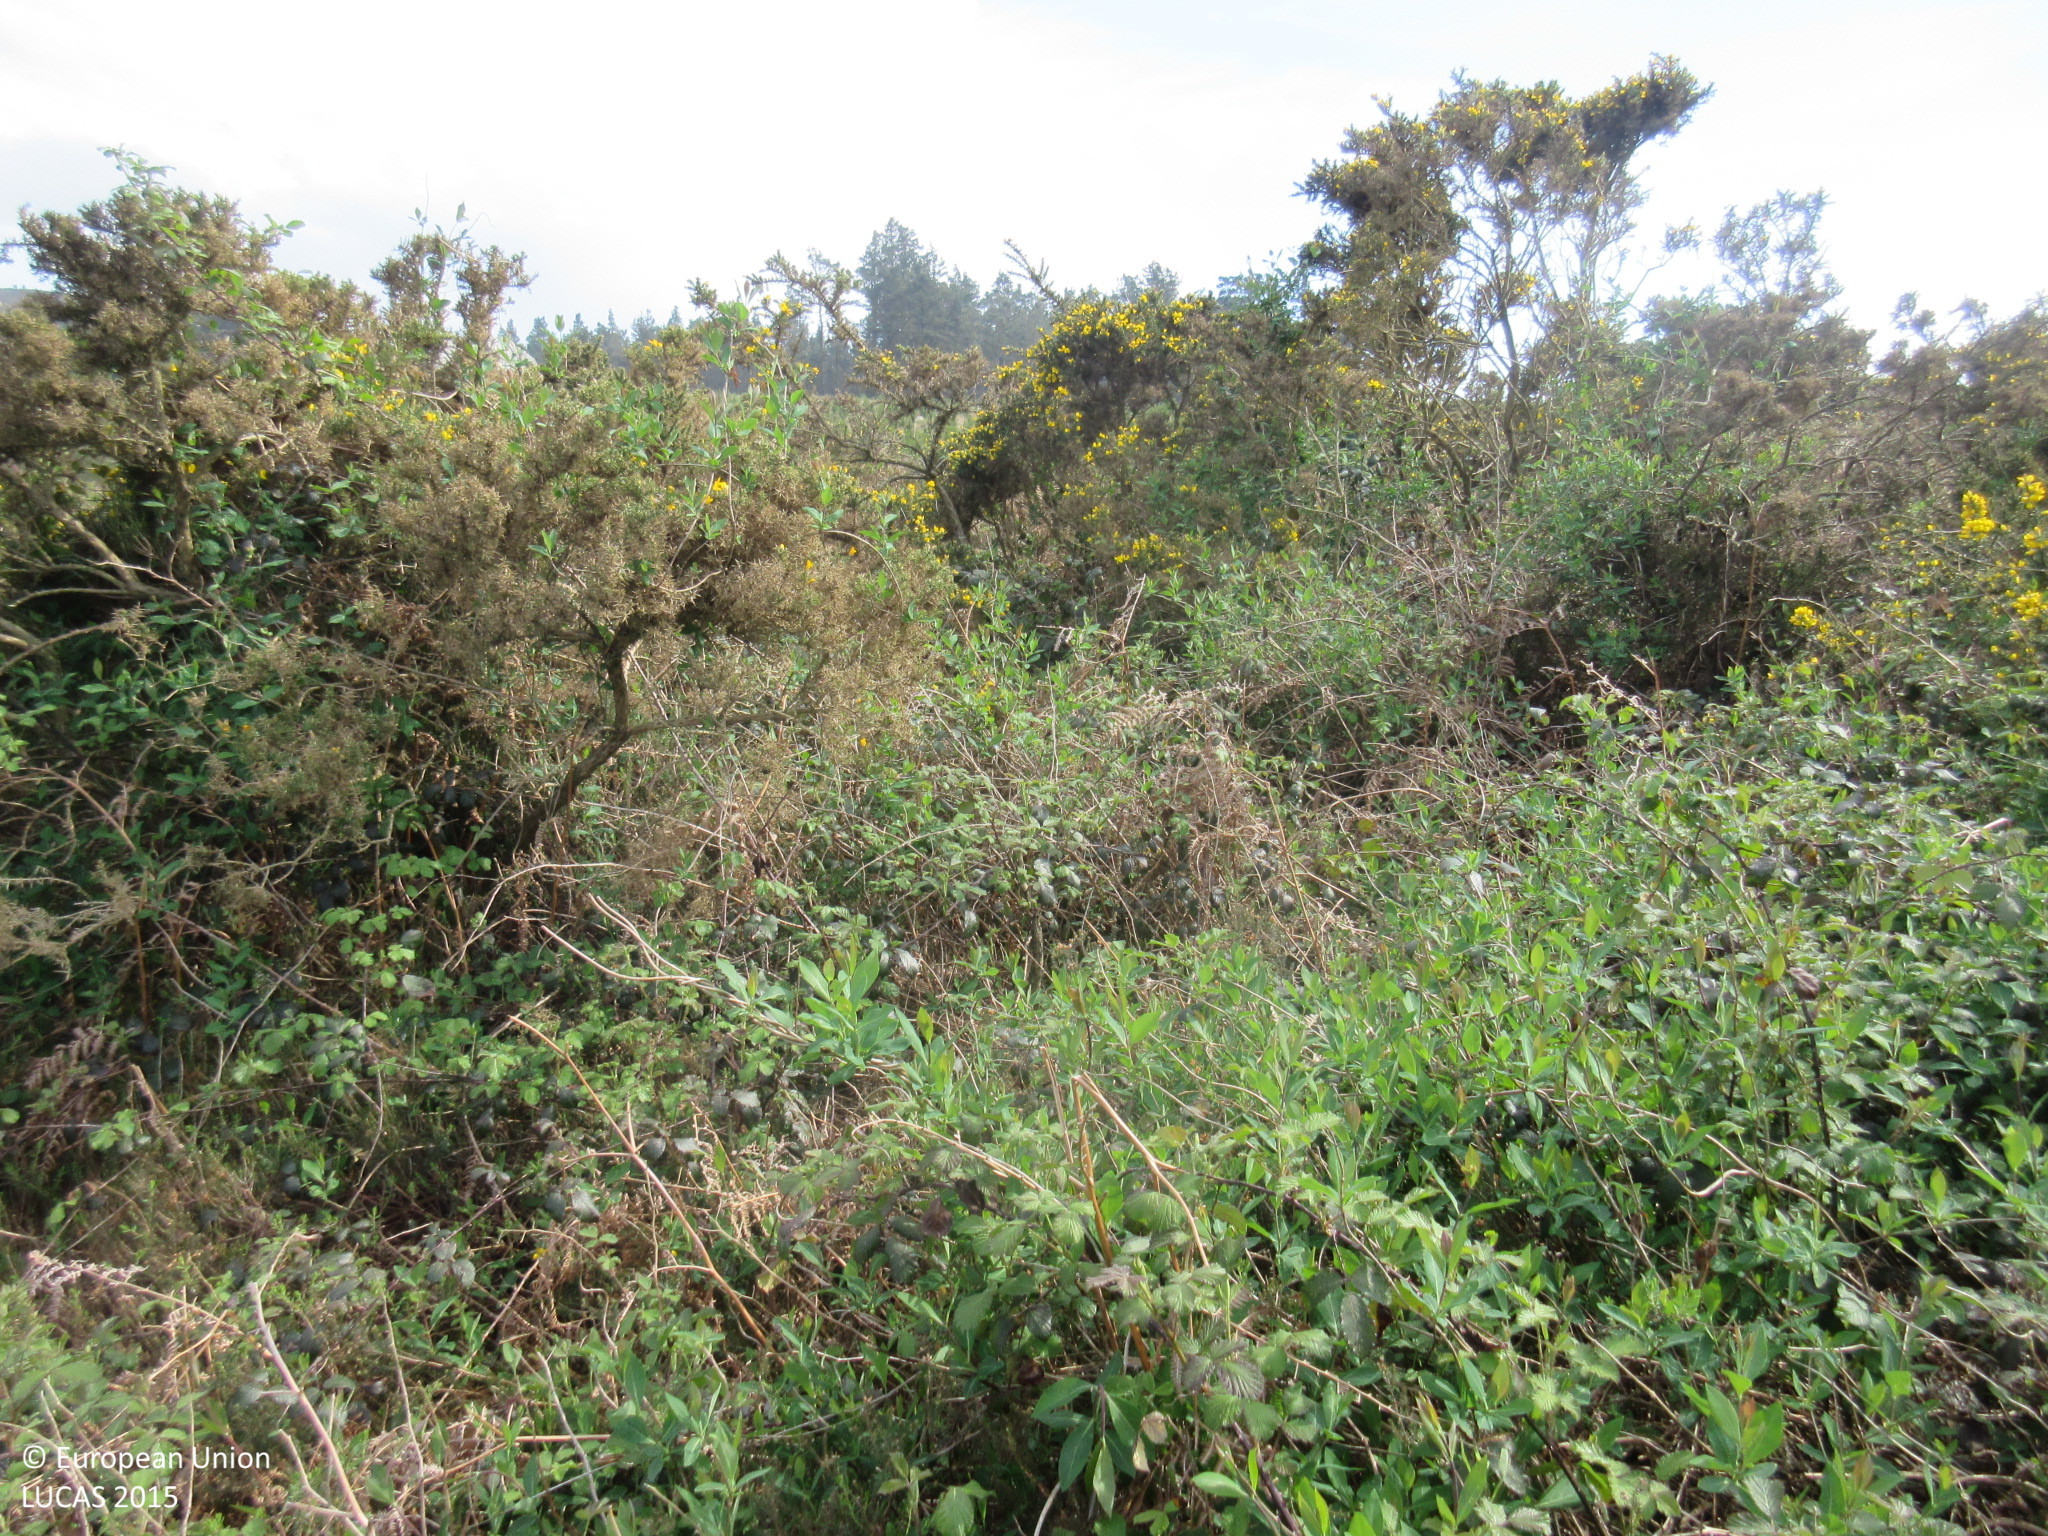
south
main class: Shrubland
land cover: Shrubland without tree cover
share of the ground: > 75 %
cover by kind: shrubs 100 %
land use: Semi-natural and natural areas not in use
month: April
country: ES
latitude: 43.4396
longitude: -6.9556
